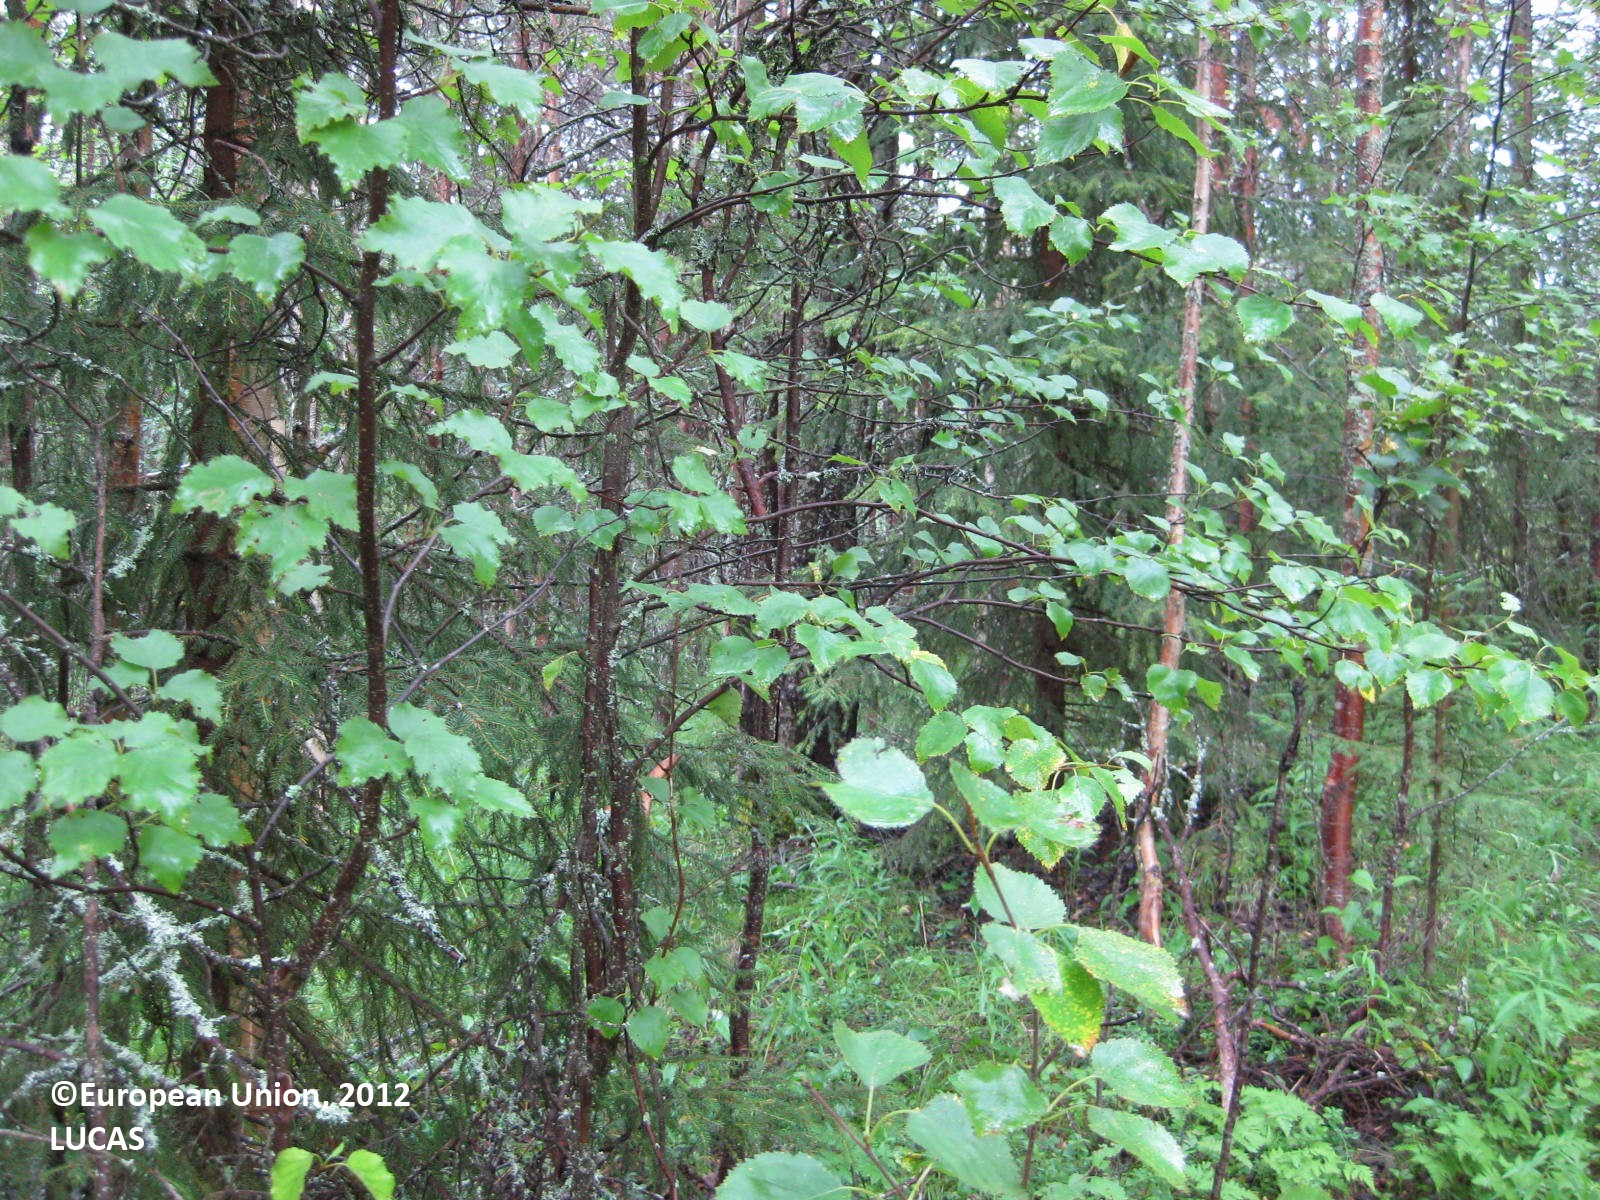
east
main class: Woodland
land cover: Other mixed woodland
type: boreal forest
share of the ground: 50 - 75 %
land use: Forestry
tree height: > 5 m
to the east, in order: Other mixed woodland; Broadleaved woodland; Electric lines; Other mixed woodland; Peatbogs; Pine dominated mixed woodland; Pine dominated coniferous woodland; Pine dominated mixed woodland
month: August
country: FI
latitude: 65.8592
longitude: 28.1341
